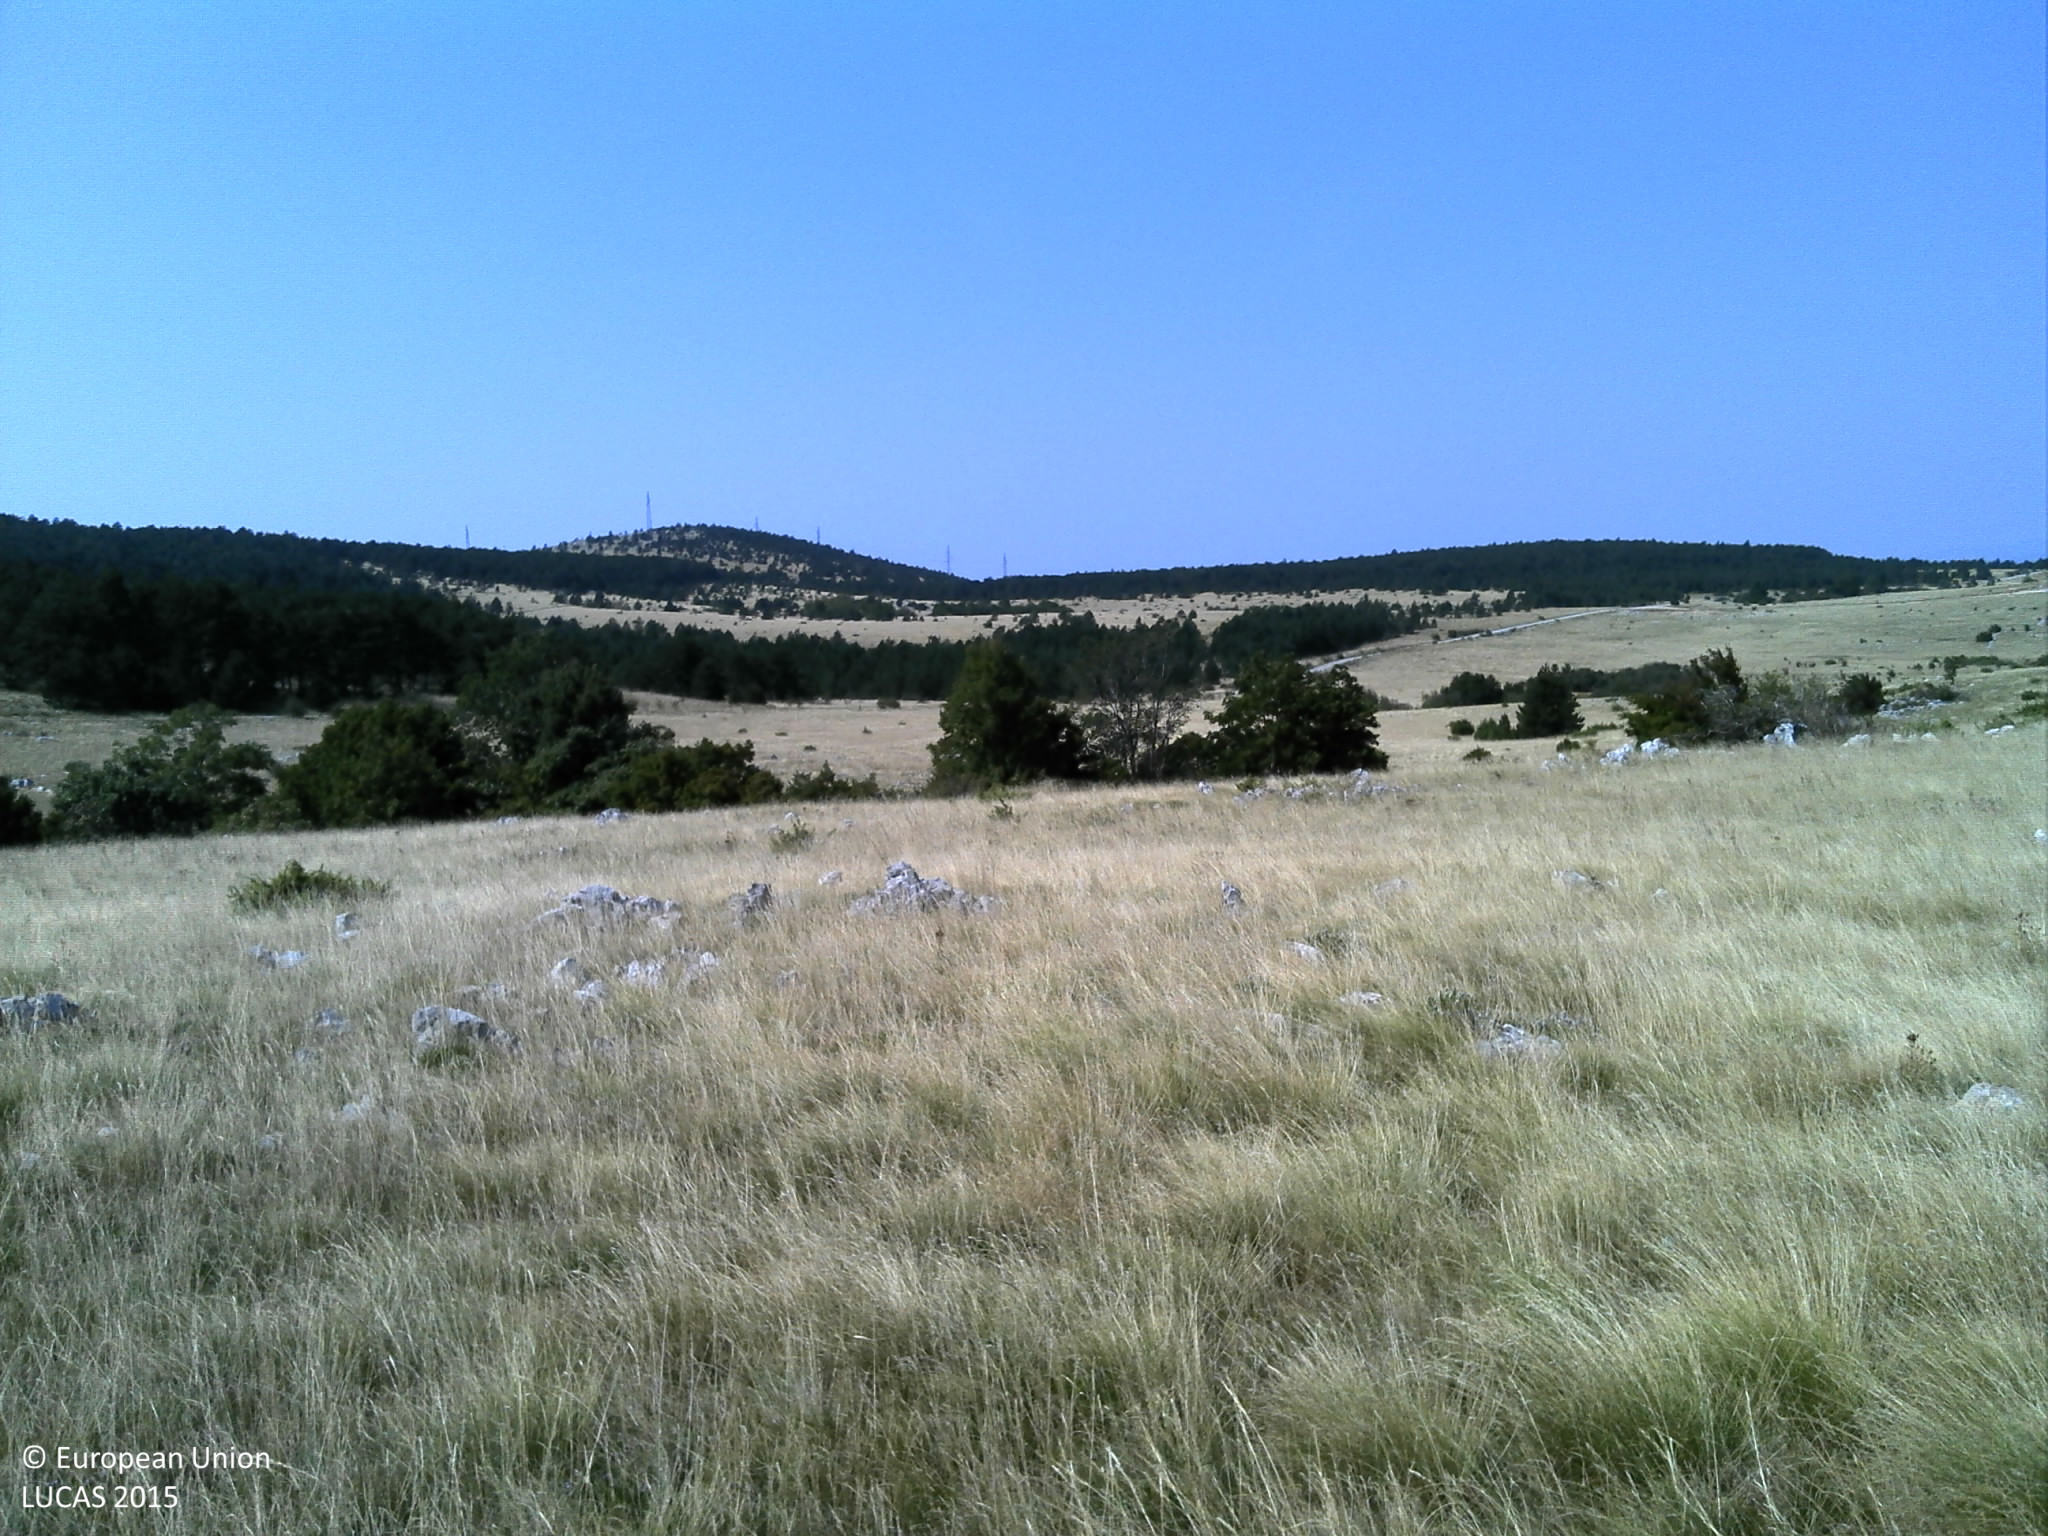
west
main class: Grassland
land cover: Grassland without tree/shrub cover
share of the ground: > 75 %
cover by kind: herbaceous plants 90 %, consolidated bare surface 5 %, unconsolidated bare surface 5 %
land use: Semi-natural and natural areas not in use
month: August
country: HR
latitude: 45.0281
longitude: 14.9316
